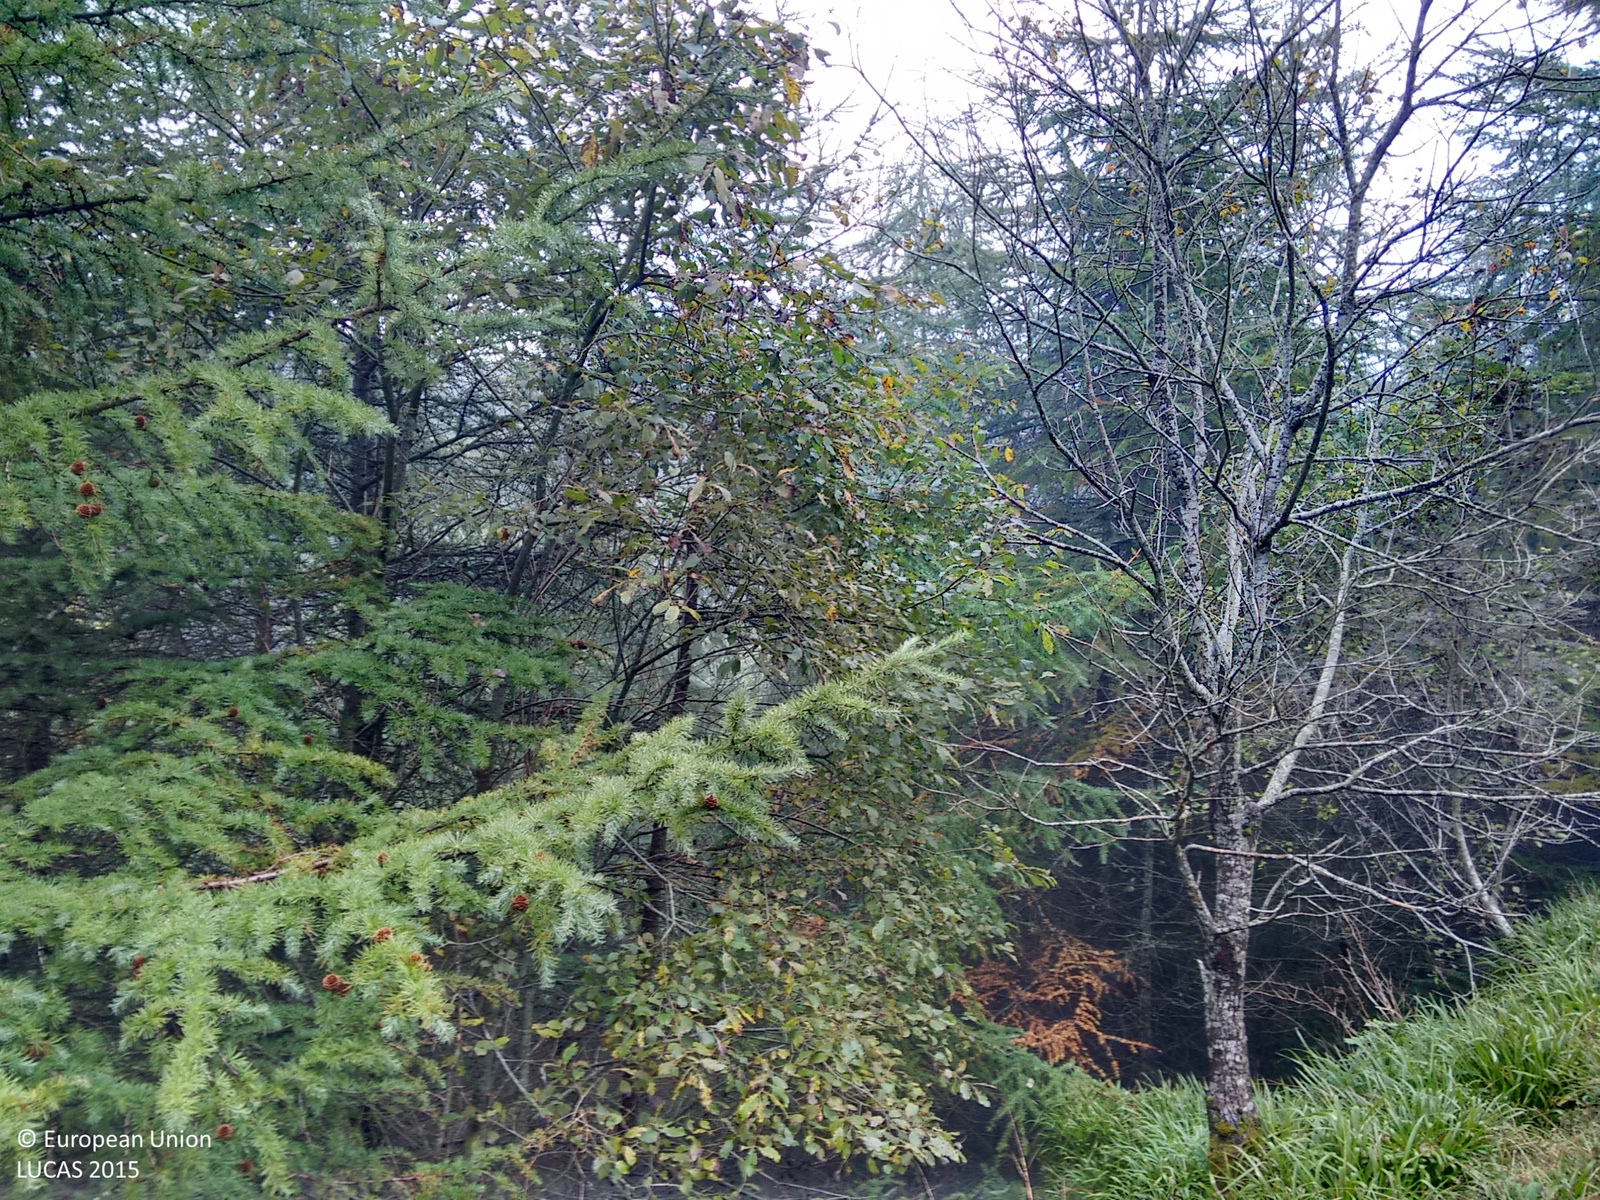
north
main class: Woodland
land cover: Pine dominated coniferous woodland
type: exotic forest
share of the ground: > 75 %
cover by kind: coniferous forest trees 80 %, shrubs 20 %
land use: Forestry
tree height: > 5 m
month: October
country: GB
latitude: 52.2779
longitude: -3.1667
